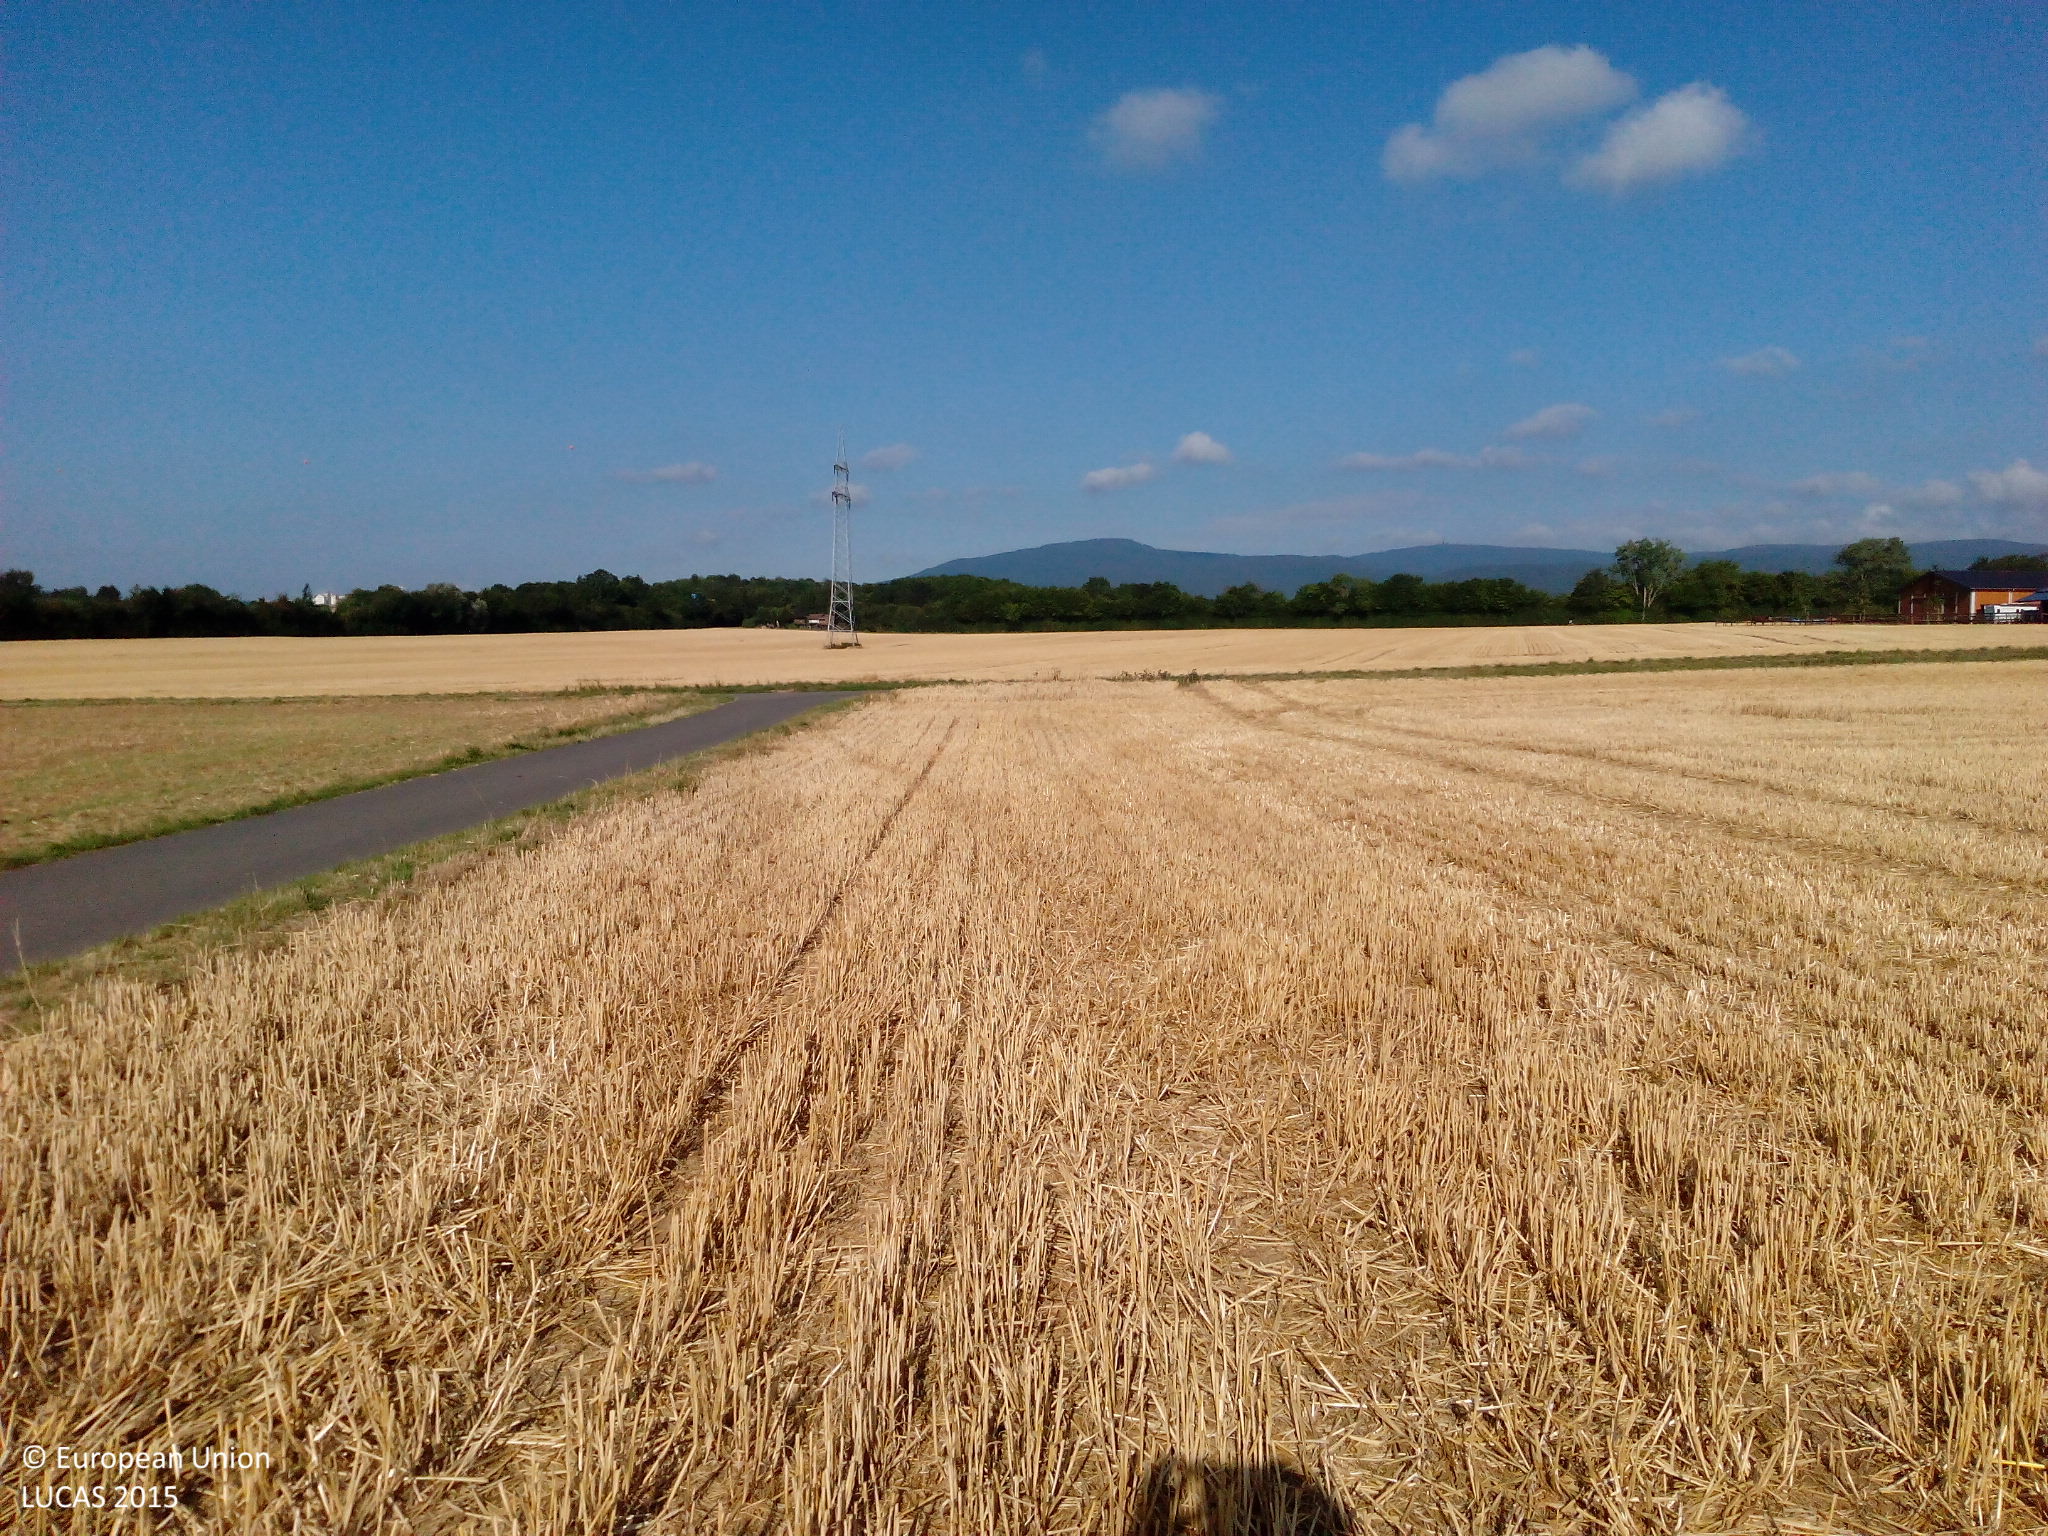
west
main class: Cropland
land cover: Common wheat
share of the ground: 50 - 75 %
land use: Agriculture (excluding fallow land and kitchen gardens)
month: July
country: DE
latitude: 50.2118
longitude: 8.6131
